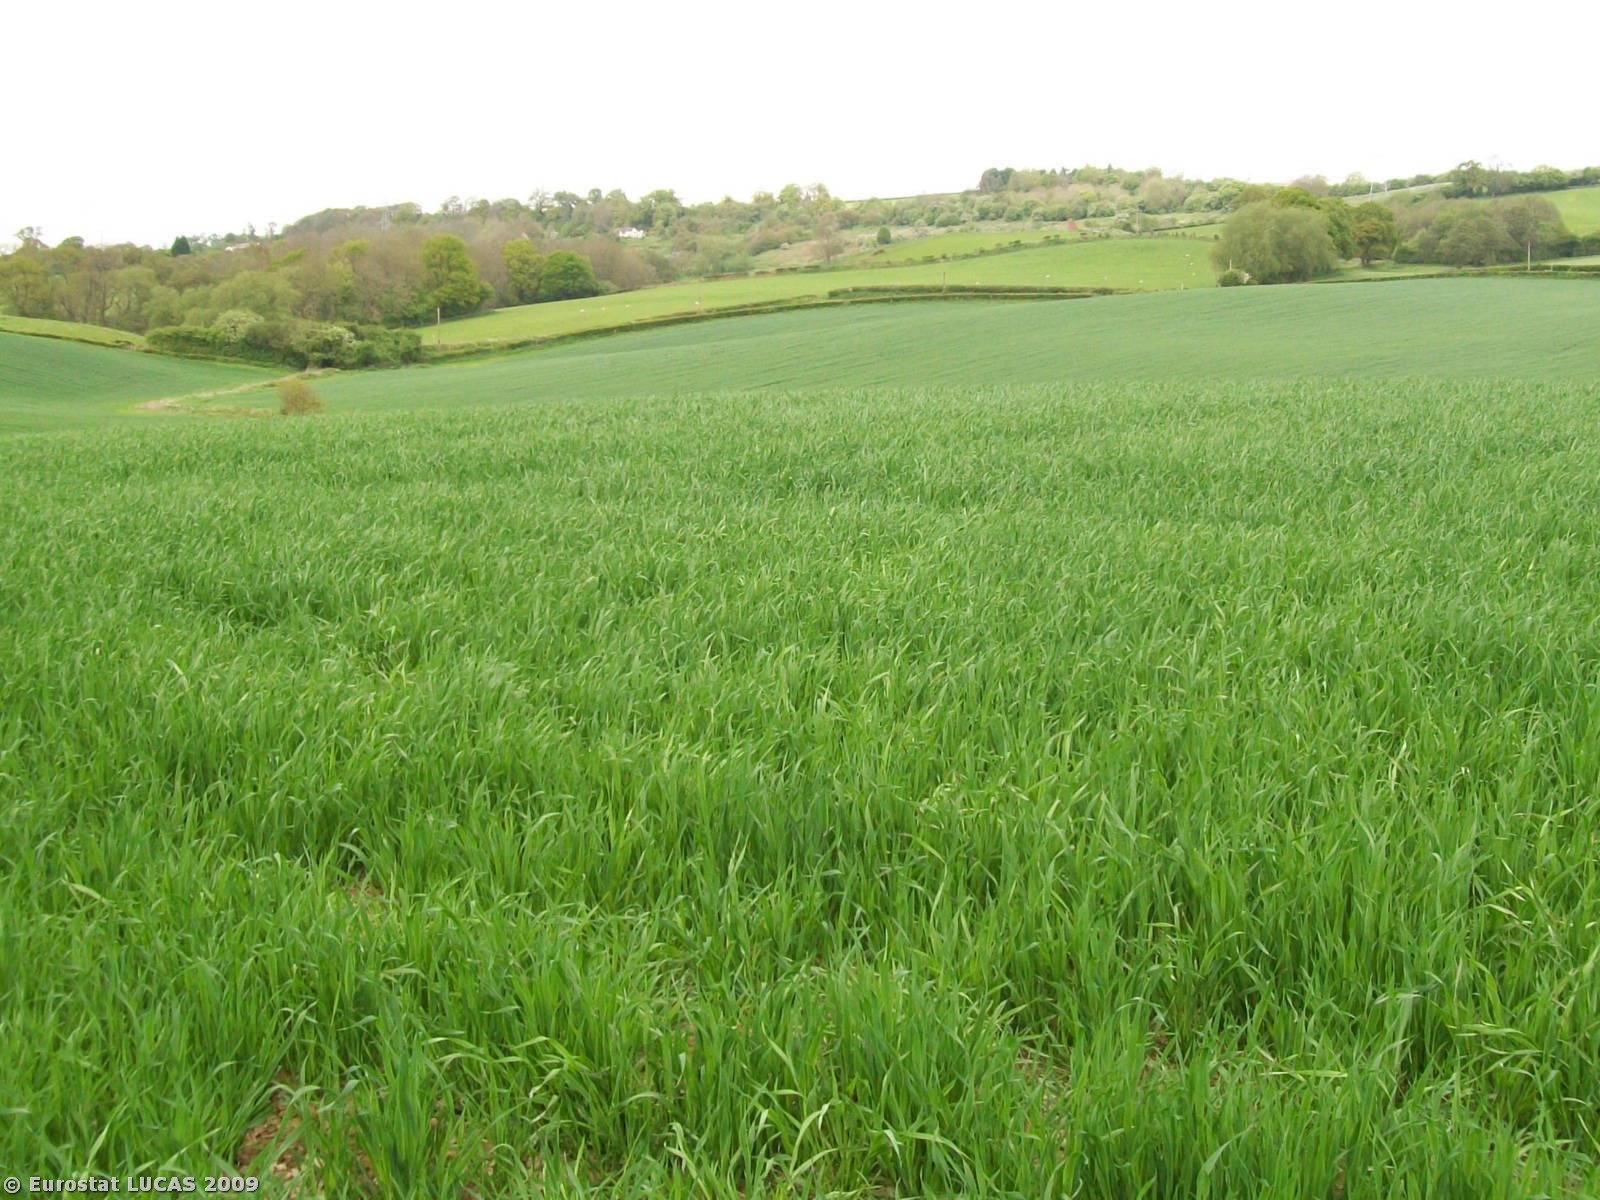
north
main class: Cropland
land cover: Oats
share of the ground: > 75 %
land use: Agriculture (excluding fallow land and kitchen gardens)
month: May
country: GB
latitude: 52.3036
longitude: -2.4281
